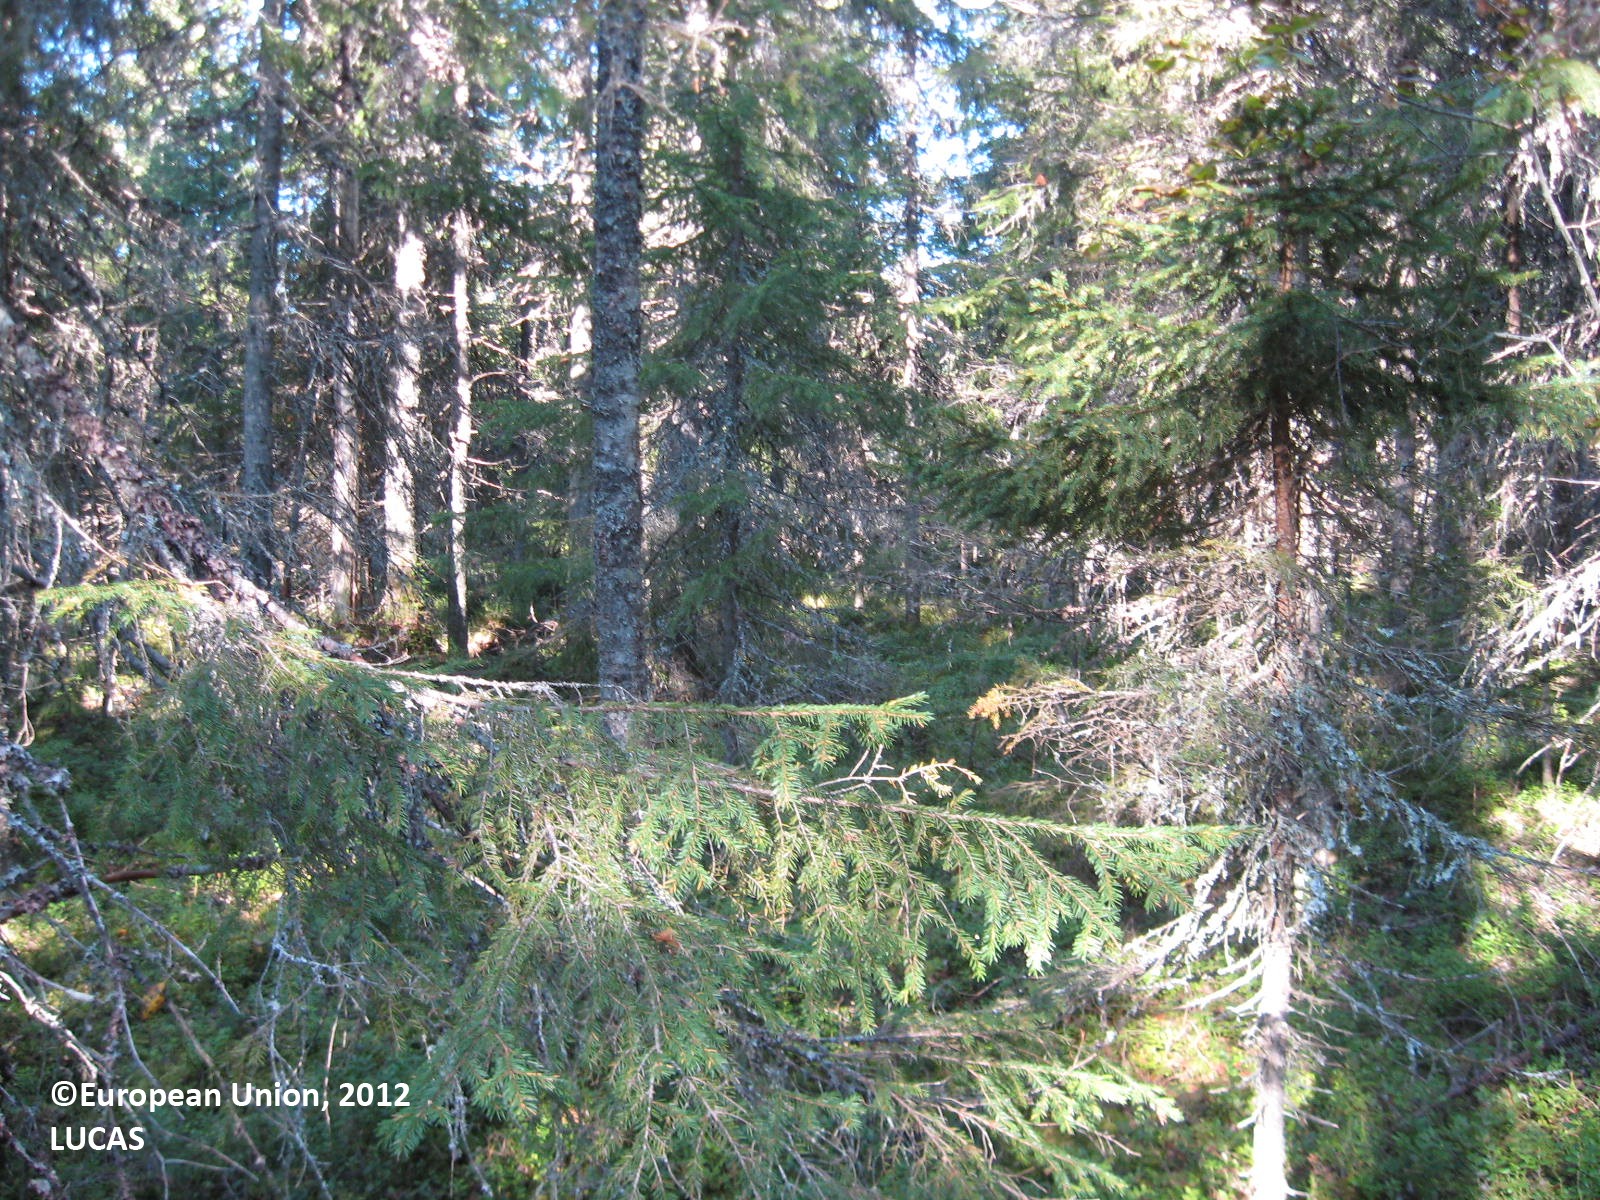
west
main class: Woodland
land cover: Spruce dominated coniferous woodland
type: boreal forest
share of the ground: > 75 %
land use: Forestry
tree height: > 5 m
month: August
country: FI
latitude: 63.7263
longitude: 29.8170
